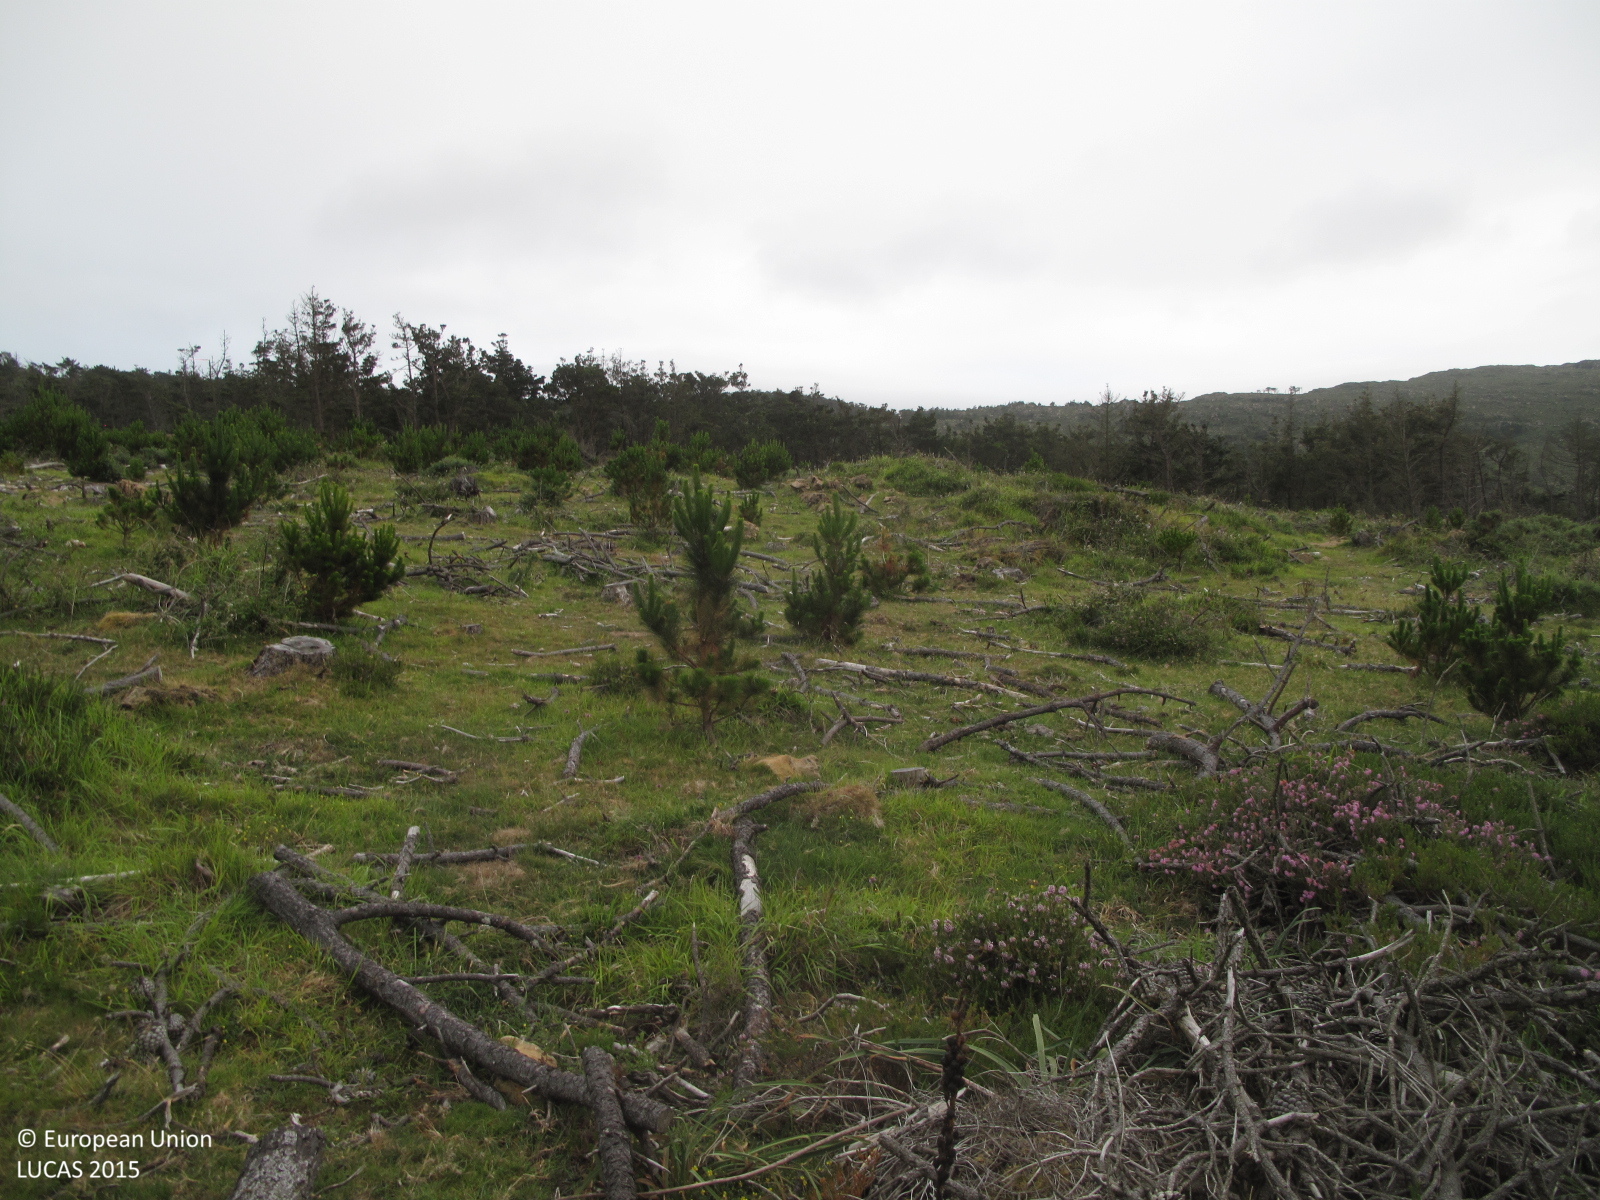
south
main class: Woodland
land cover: Pine dominated coniferous woodland
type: exotic forest
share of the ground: 25 - 50 %
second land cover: Shrubland without tree cover
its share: 10 - 25 %
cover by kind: coniferous forest trees 40 %, herbaceous plants 40 %, shrubs 20 %
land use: Forestry
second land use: Agriculture (excluding fallow land and kitchen gardens)
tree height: > 5 m
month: July
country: ES
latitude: 43.7569
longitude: -7.8942
